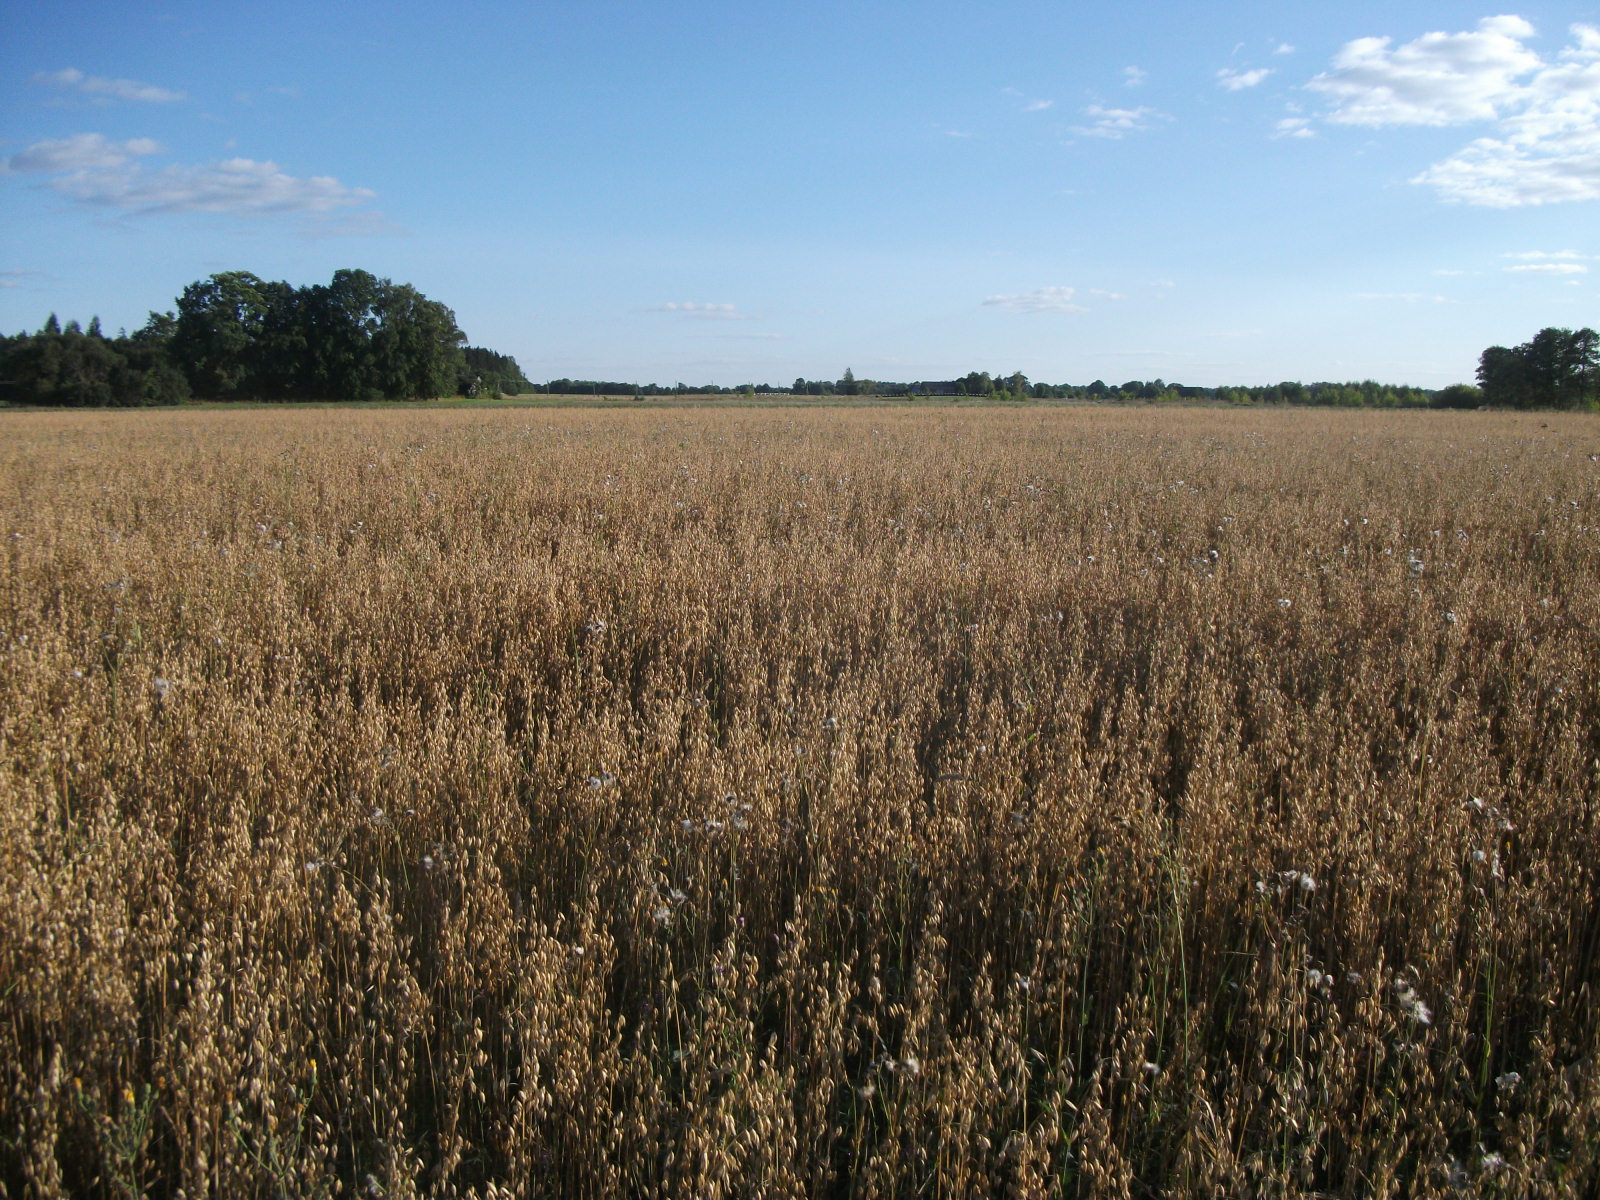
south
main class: Cropland
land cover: Oats
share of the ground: > 75 %
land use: Agriculture (excluding fallow land and kitchen gardens)
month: August
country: LV
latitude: 56.3612
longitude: 26.3464
